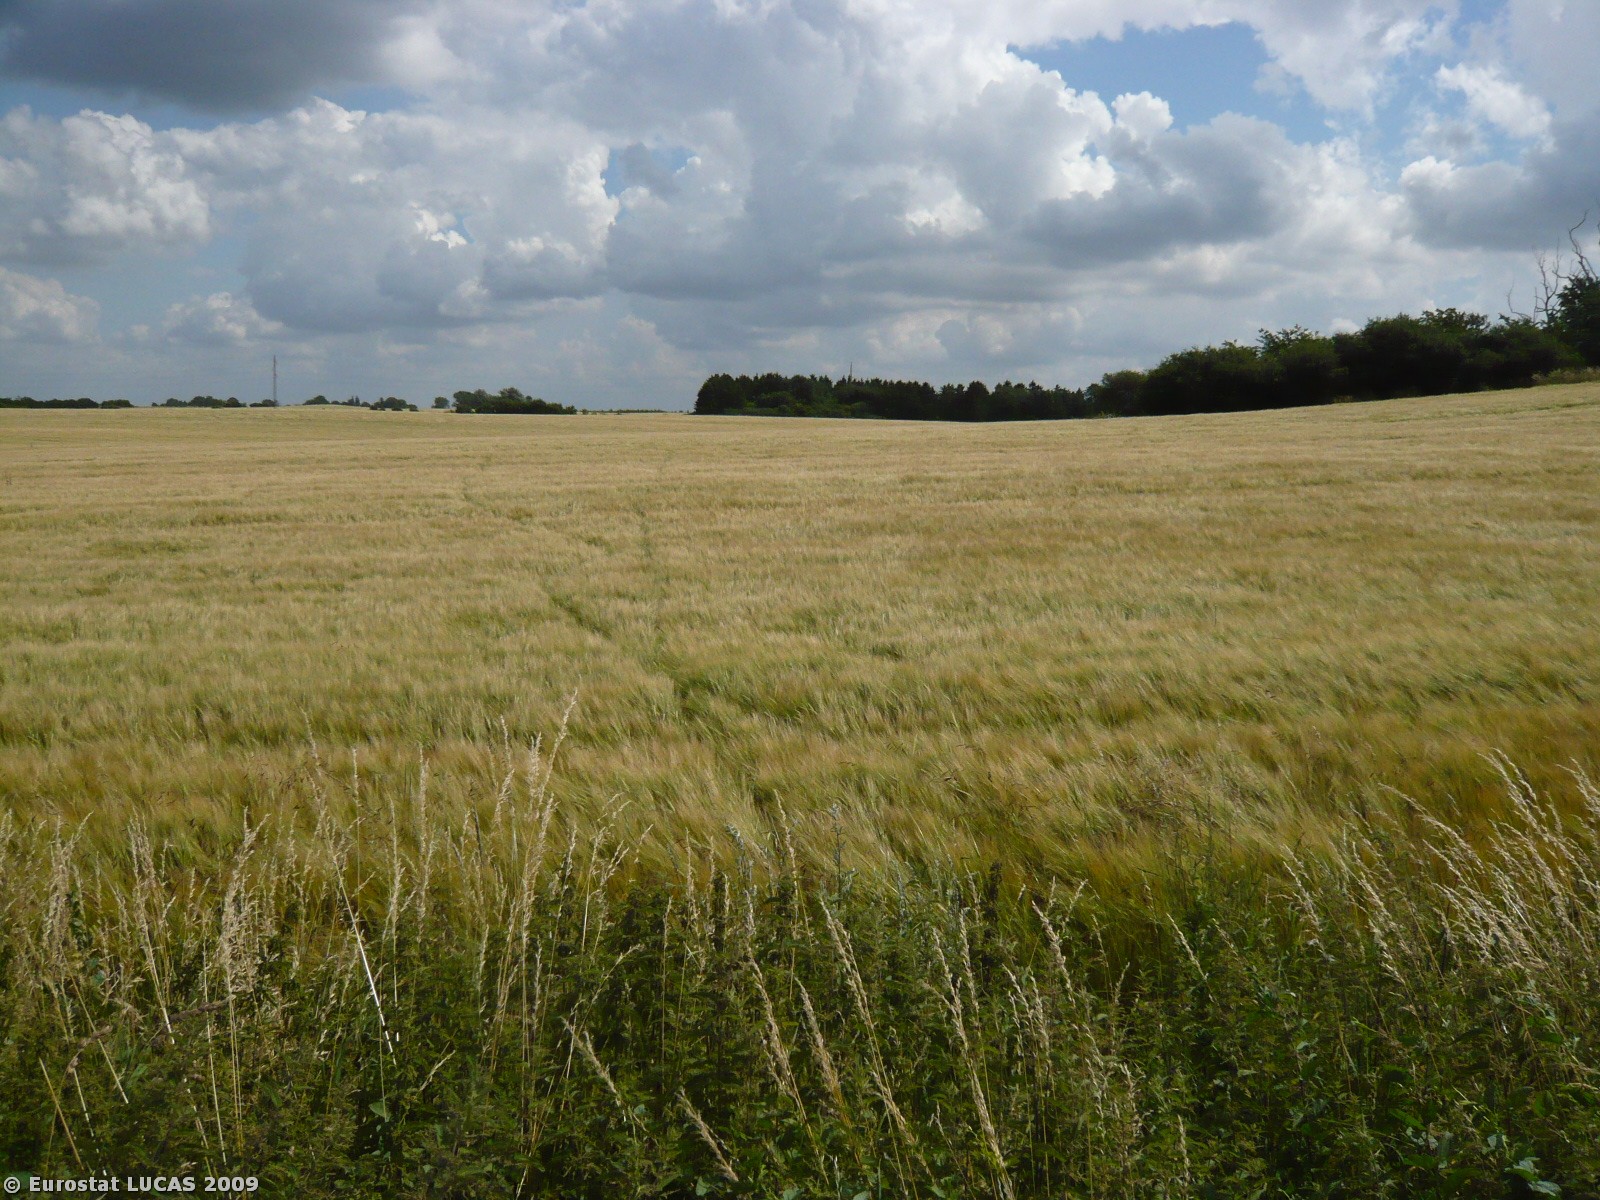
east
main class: Cropland
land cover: Barley
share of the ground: > 75 %
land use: Agriculture (excluding fallow land and kitchen gardens)
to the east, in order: Barley; Bare land; Broadleaved woodland; Coniferous woodland; Electric lines; Coniferous woodland; Barley
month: July
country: DK
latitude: 55.6902
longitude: 11.7641
